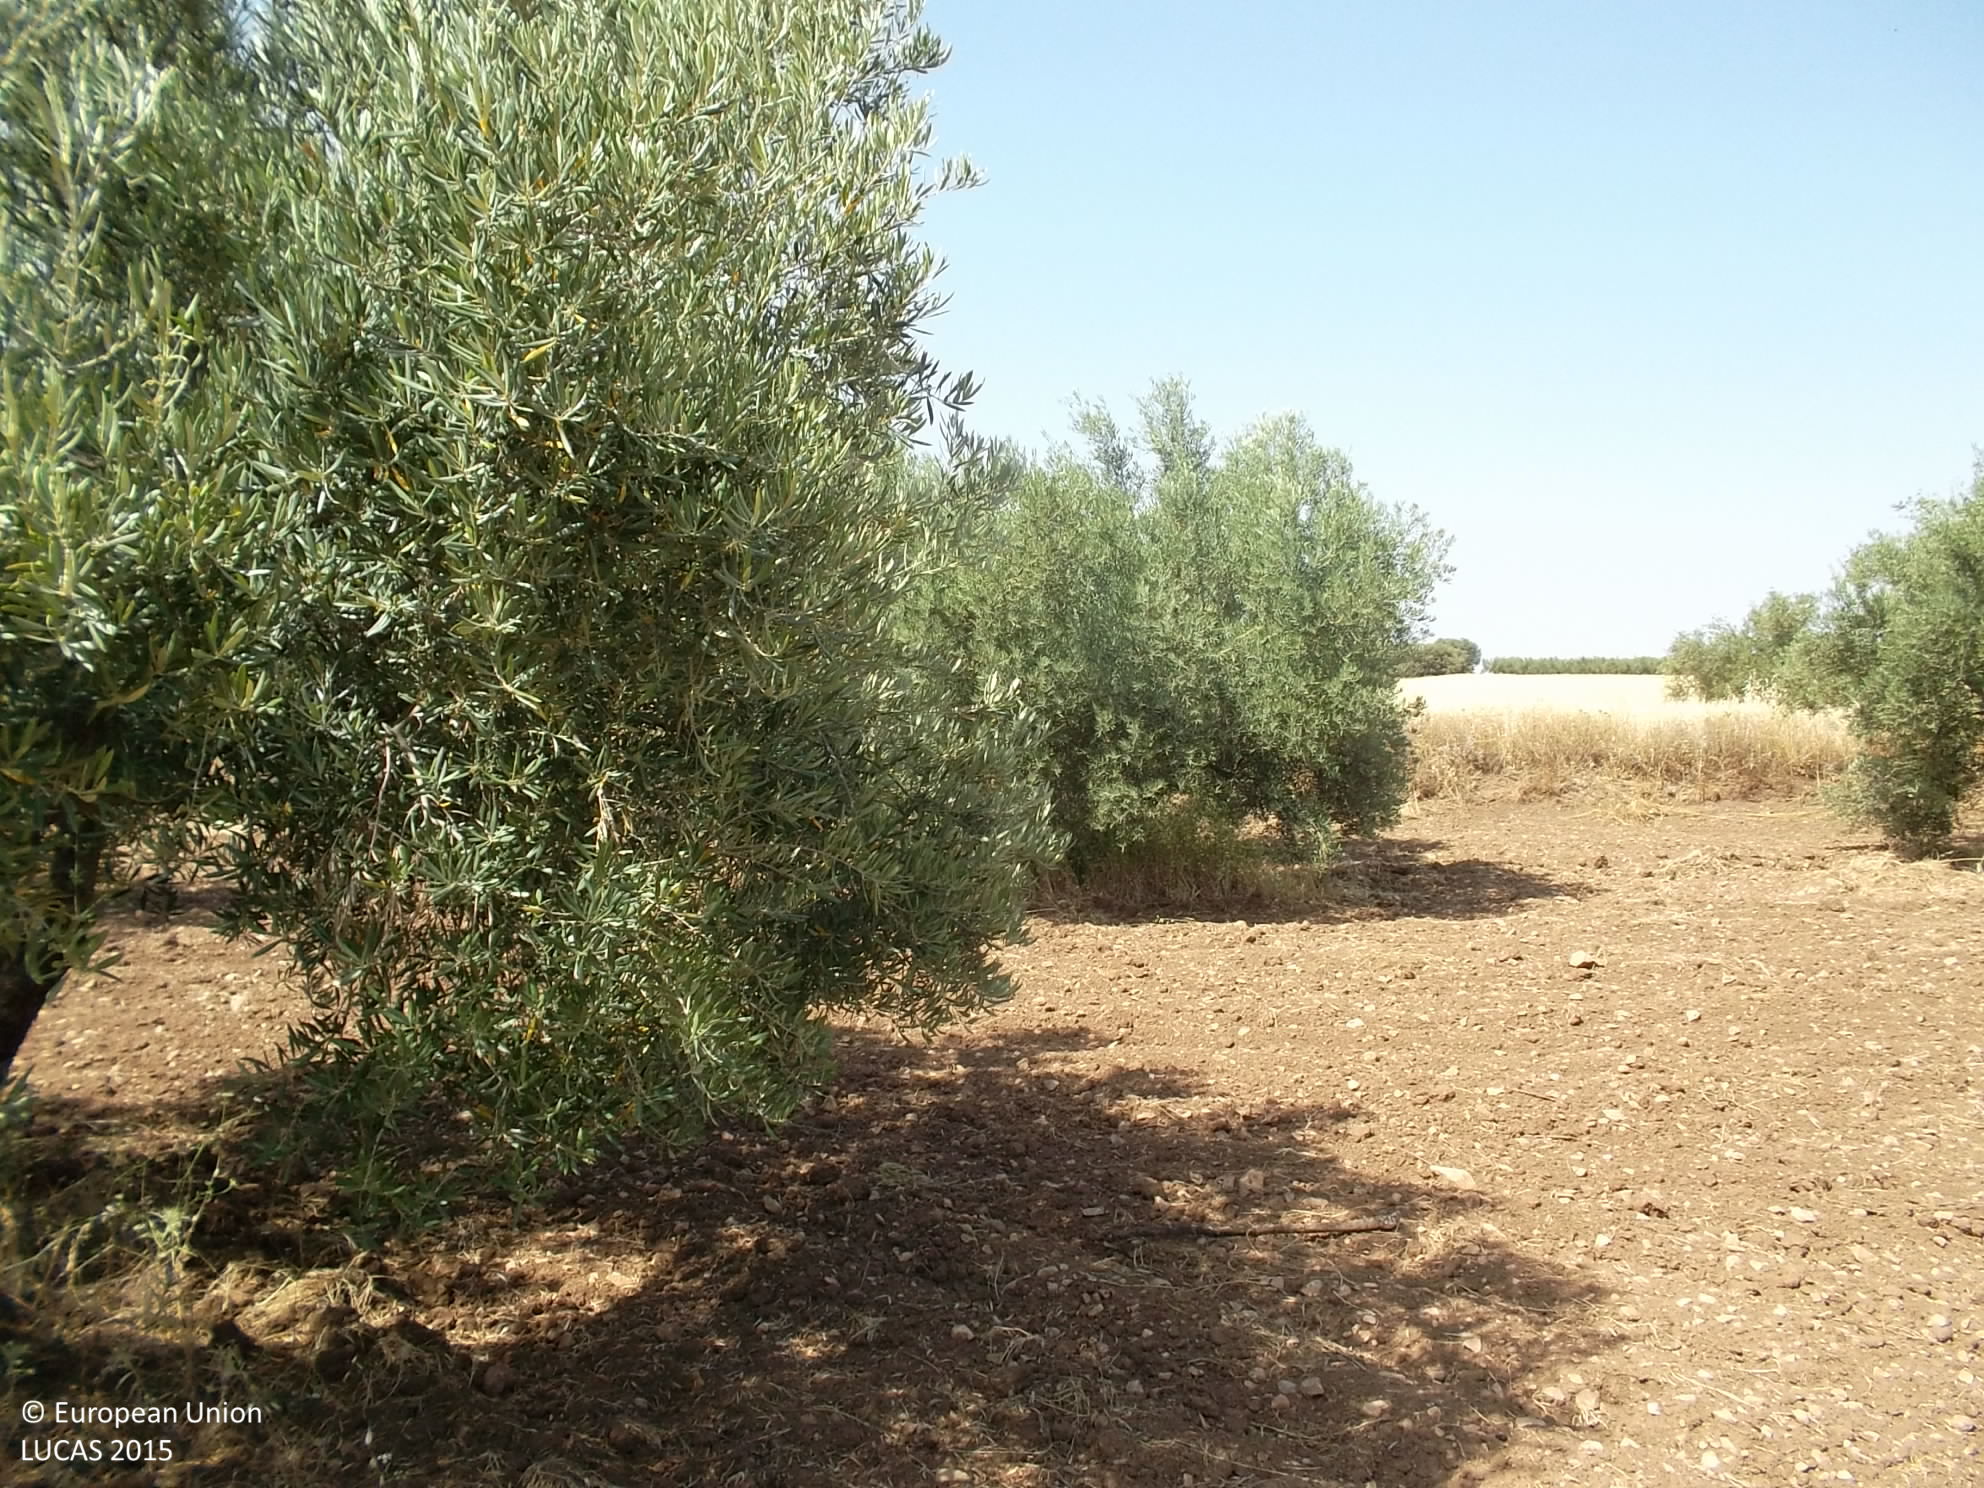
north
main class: Cropland
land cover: Olive groves
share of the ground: 50 - 75 %
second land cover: Other bare soil
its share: > 75 %
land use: Agriculture (excluding fallow land and kitchen gardens)
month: June
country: ES
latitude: 37.7457
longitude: -2.8954
